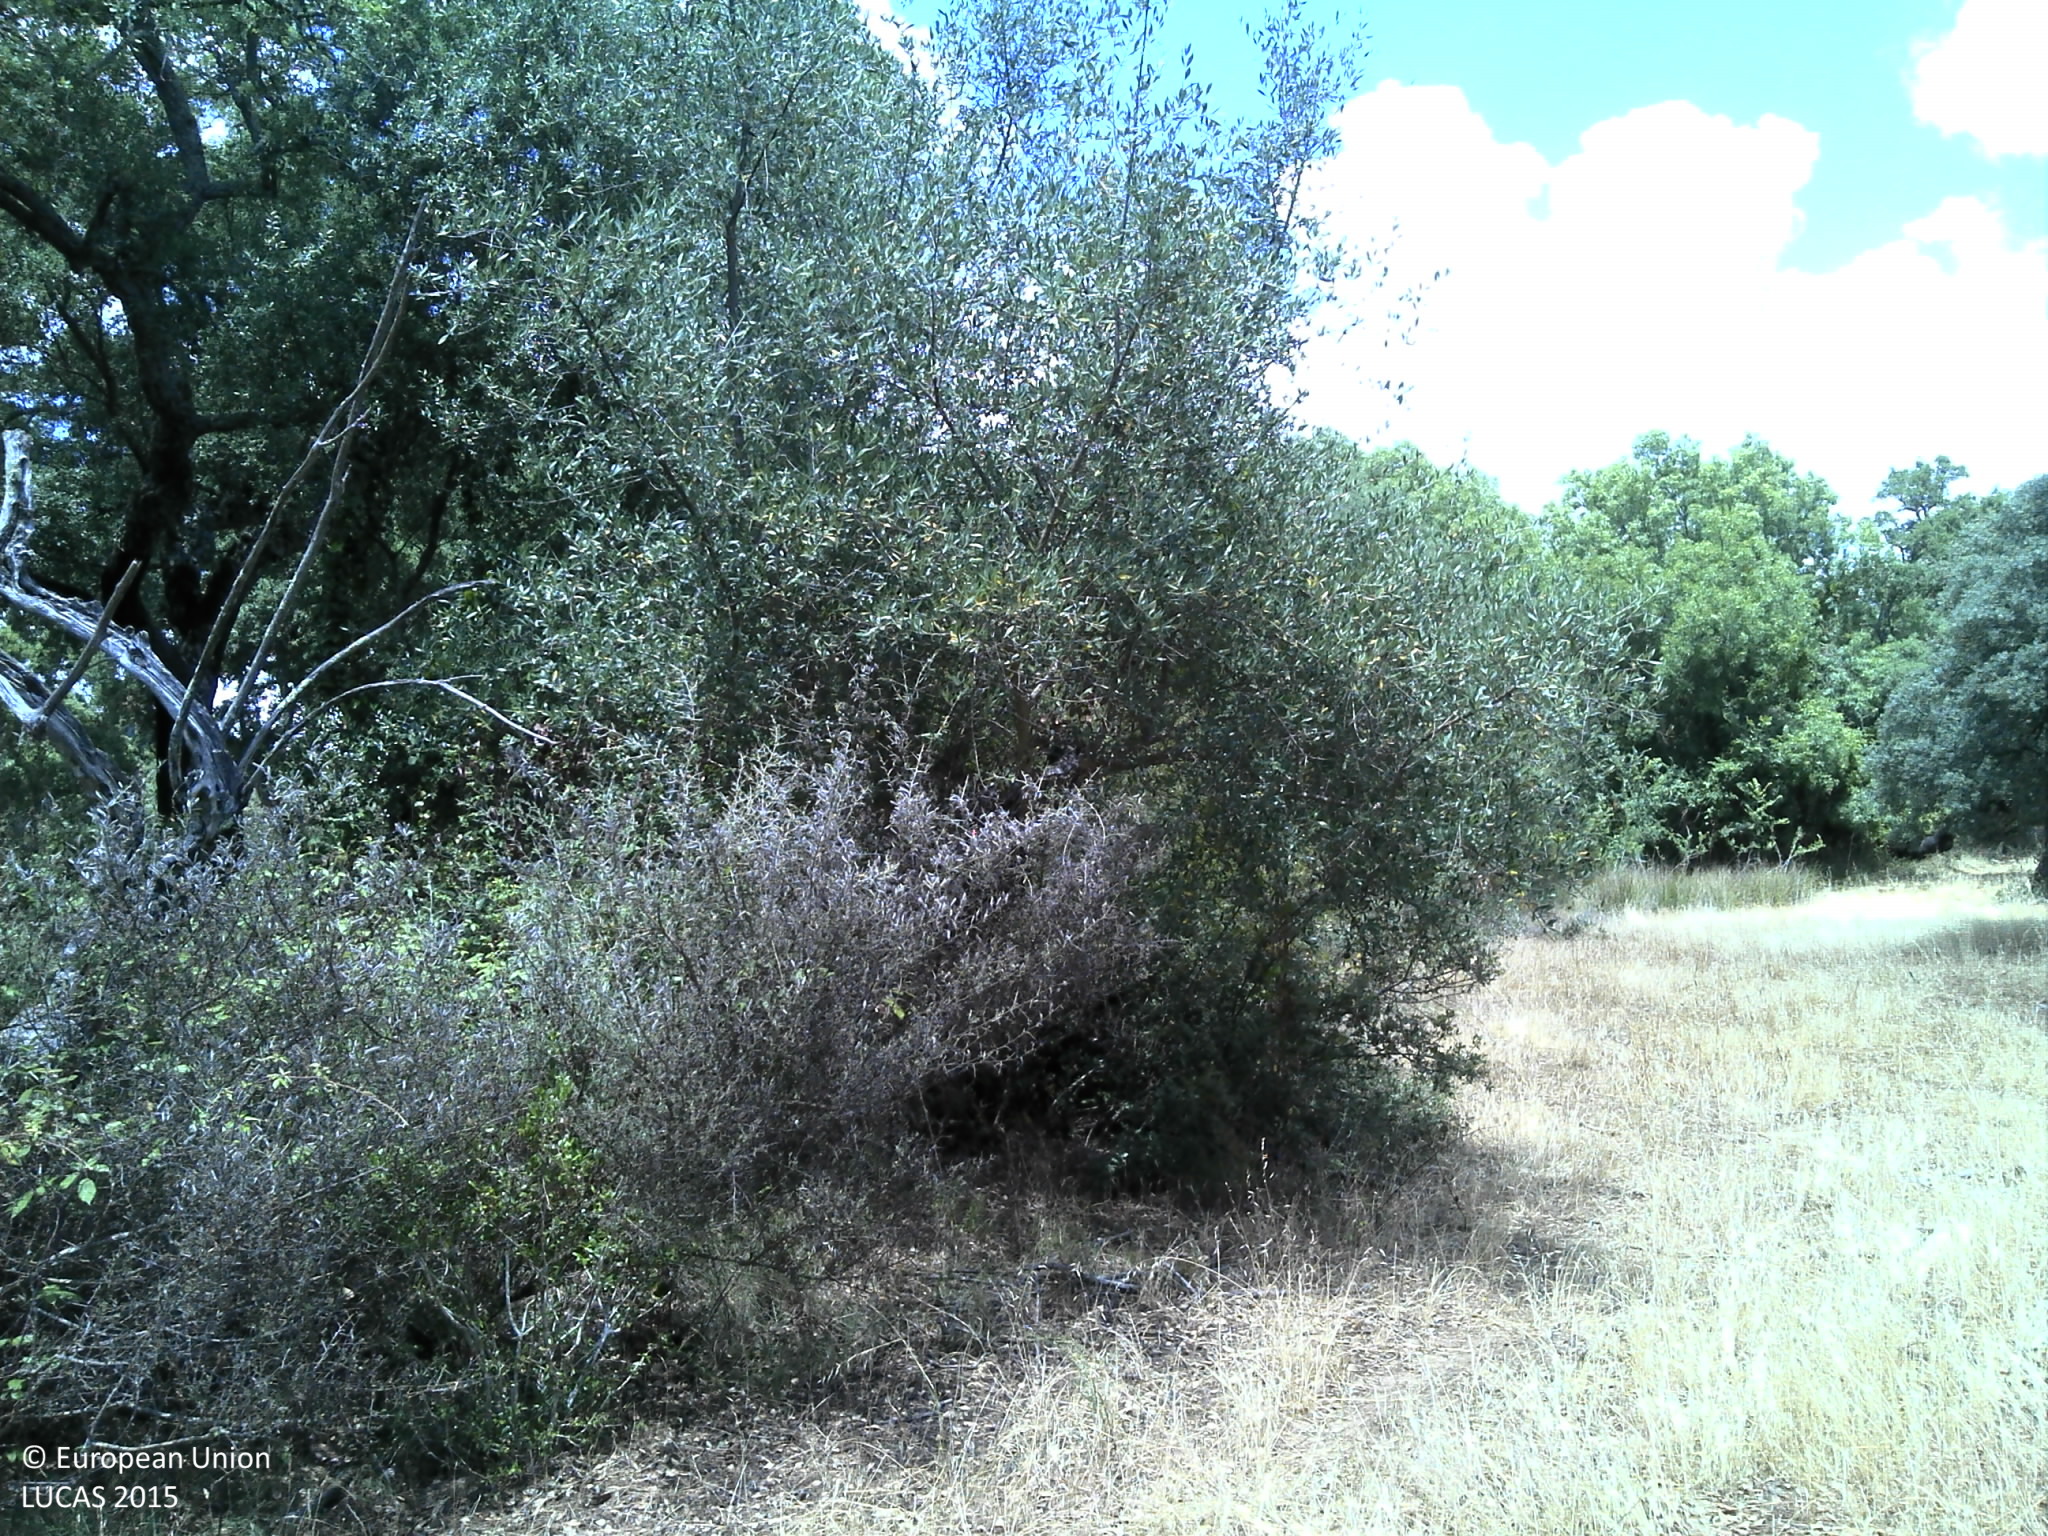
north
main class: Woodland
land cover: Broadleaved woodland
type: broadleaved evergreen forest
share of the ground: 50 - 75 %
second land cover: Grassland without tree/shrub cover
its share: 10 - 25 %
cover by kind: broadleaved forest trees 60 %, unconsolidated bare surface 25 %, herbaceous plants 15 %
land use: Forestry
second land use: Agriculture (excluding fallow land and kitchen gardens)
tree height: > 5 m
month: June
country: PT
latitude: 38.5246
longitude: -8.1328
